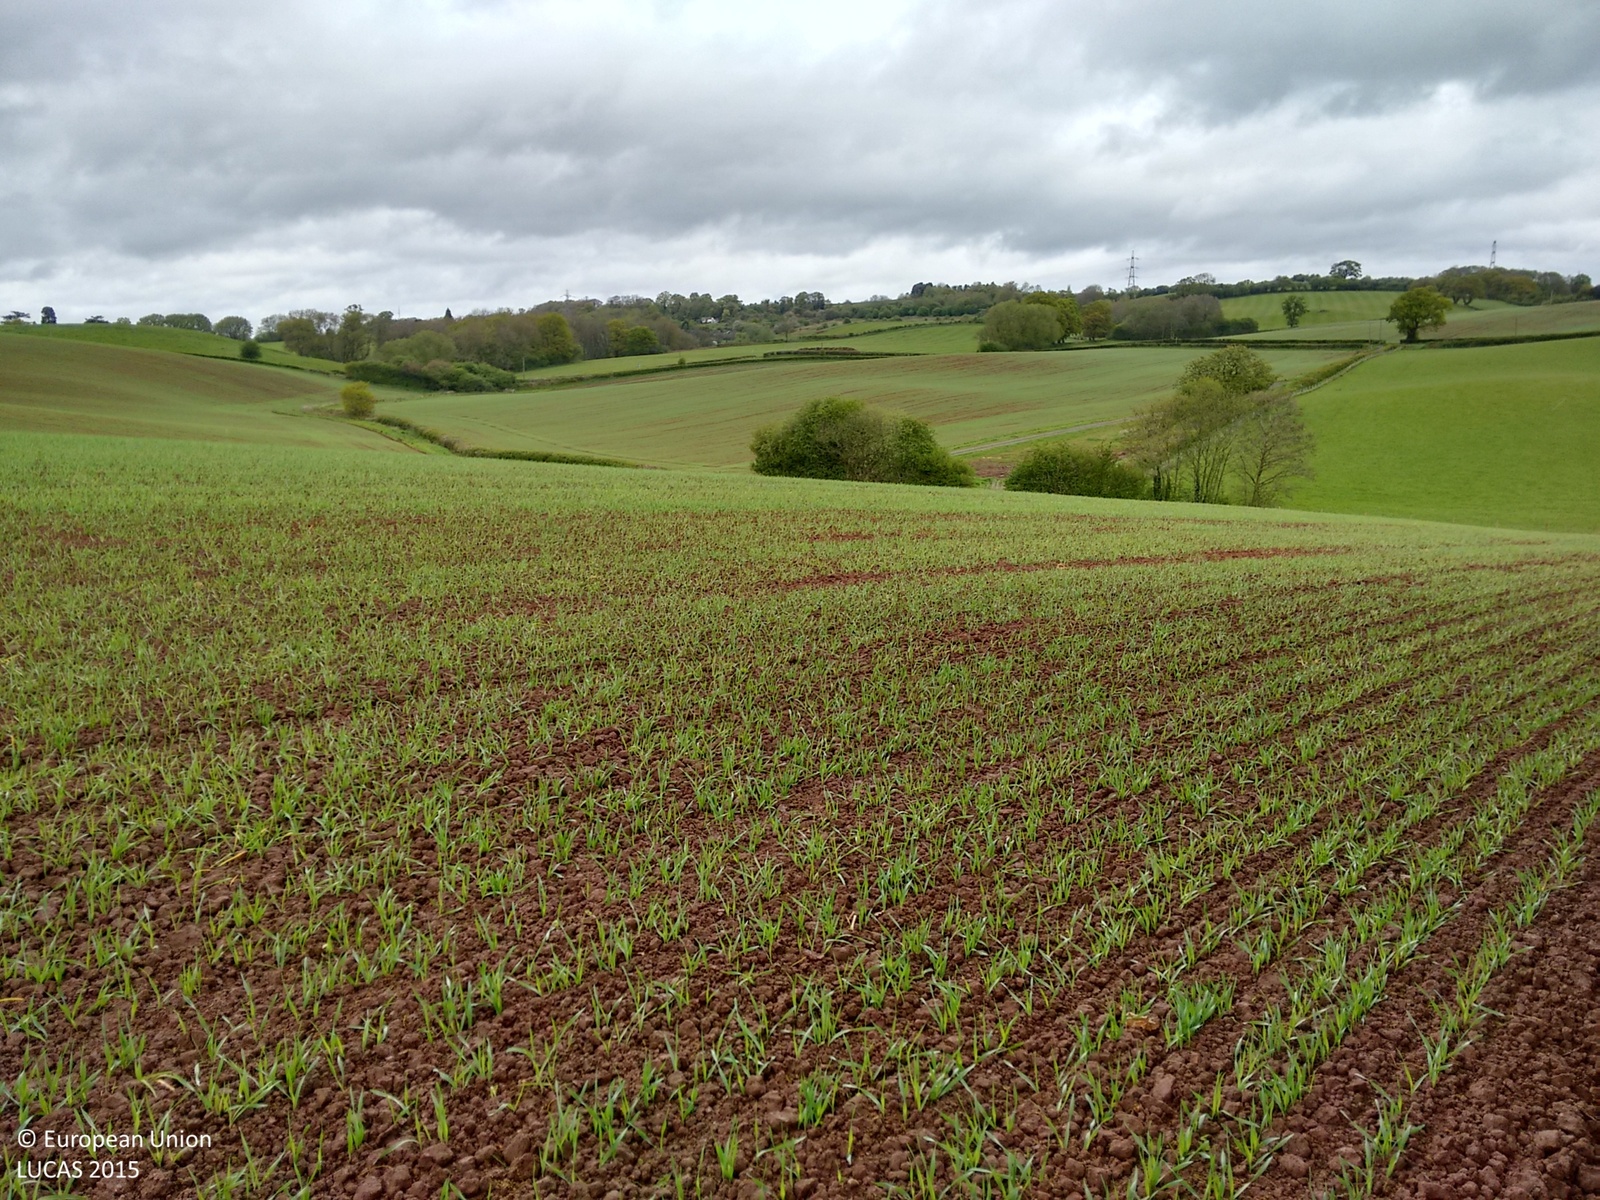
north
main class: Cropland
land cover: Barley
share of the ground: 25 - 50 %
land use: Agriculture (excluding fallow land and kitchen gardens)
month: May
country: GB
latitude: 52.3036
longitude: -2.4281
